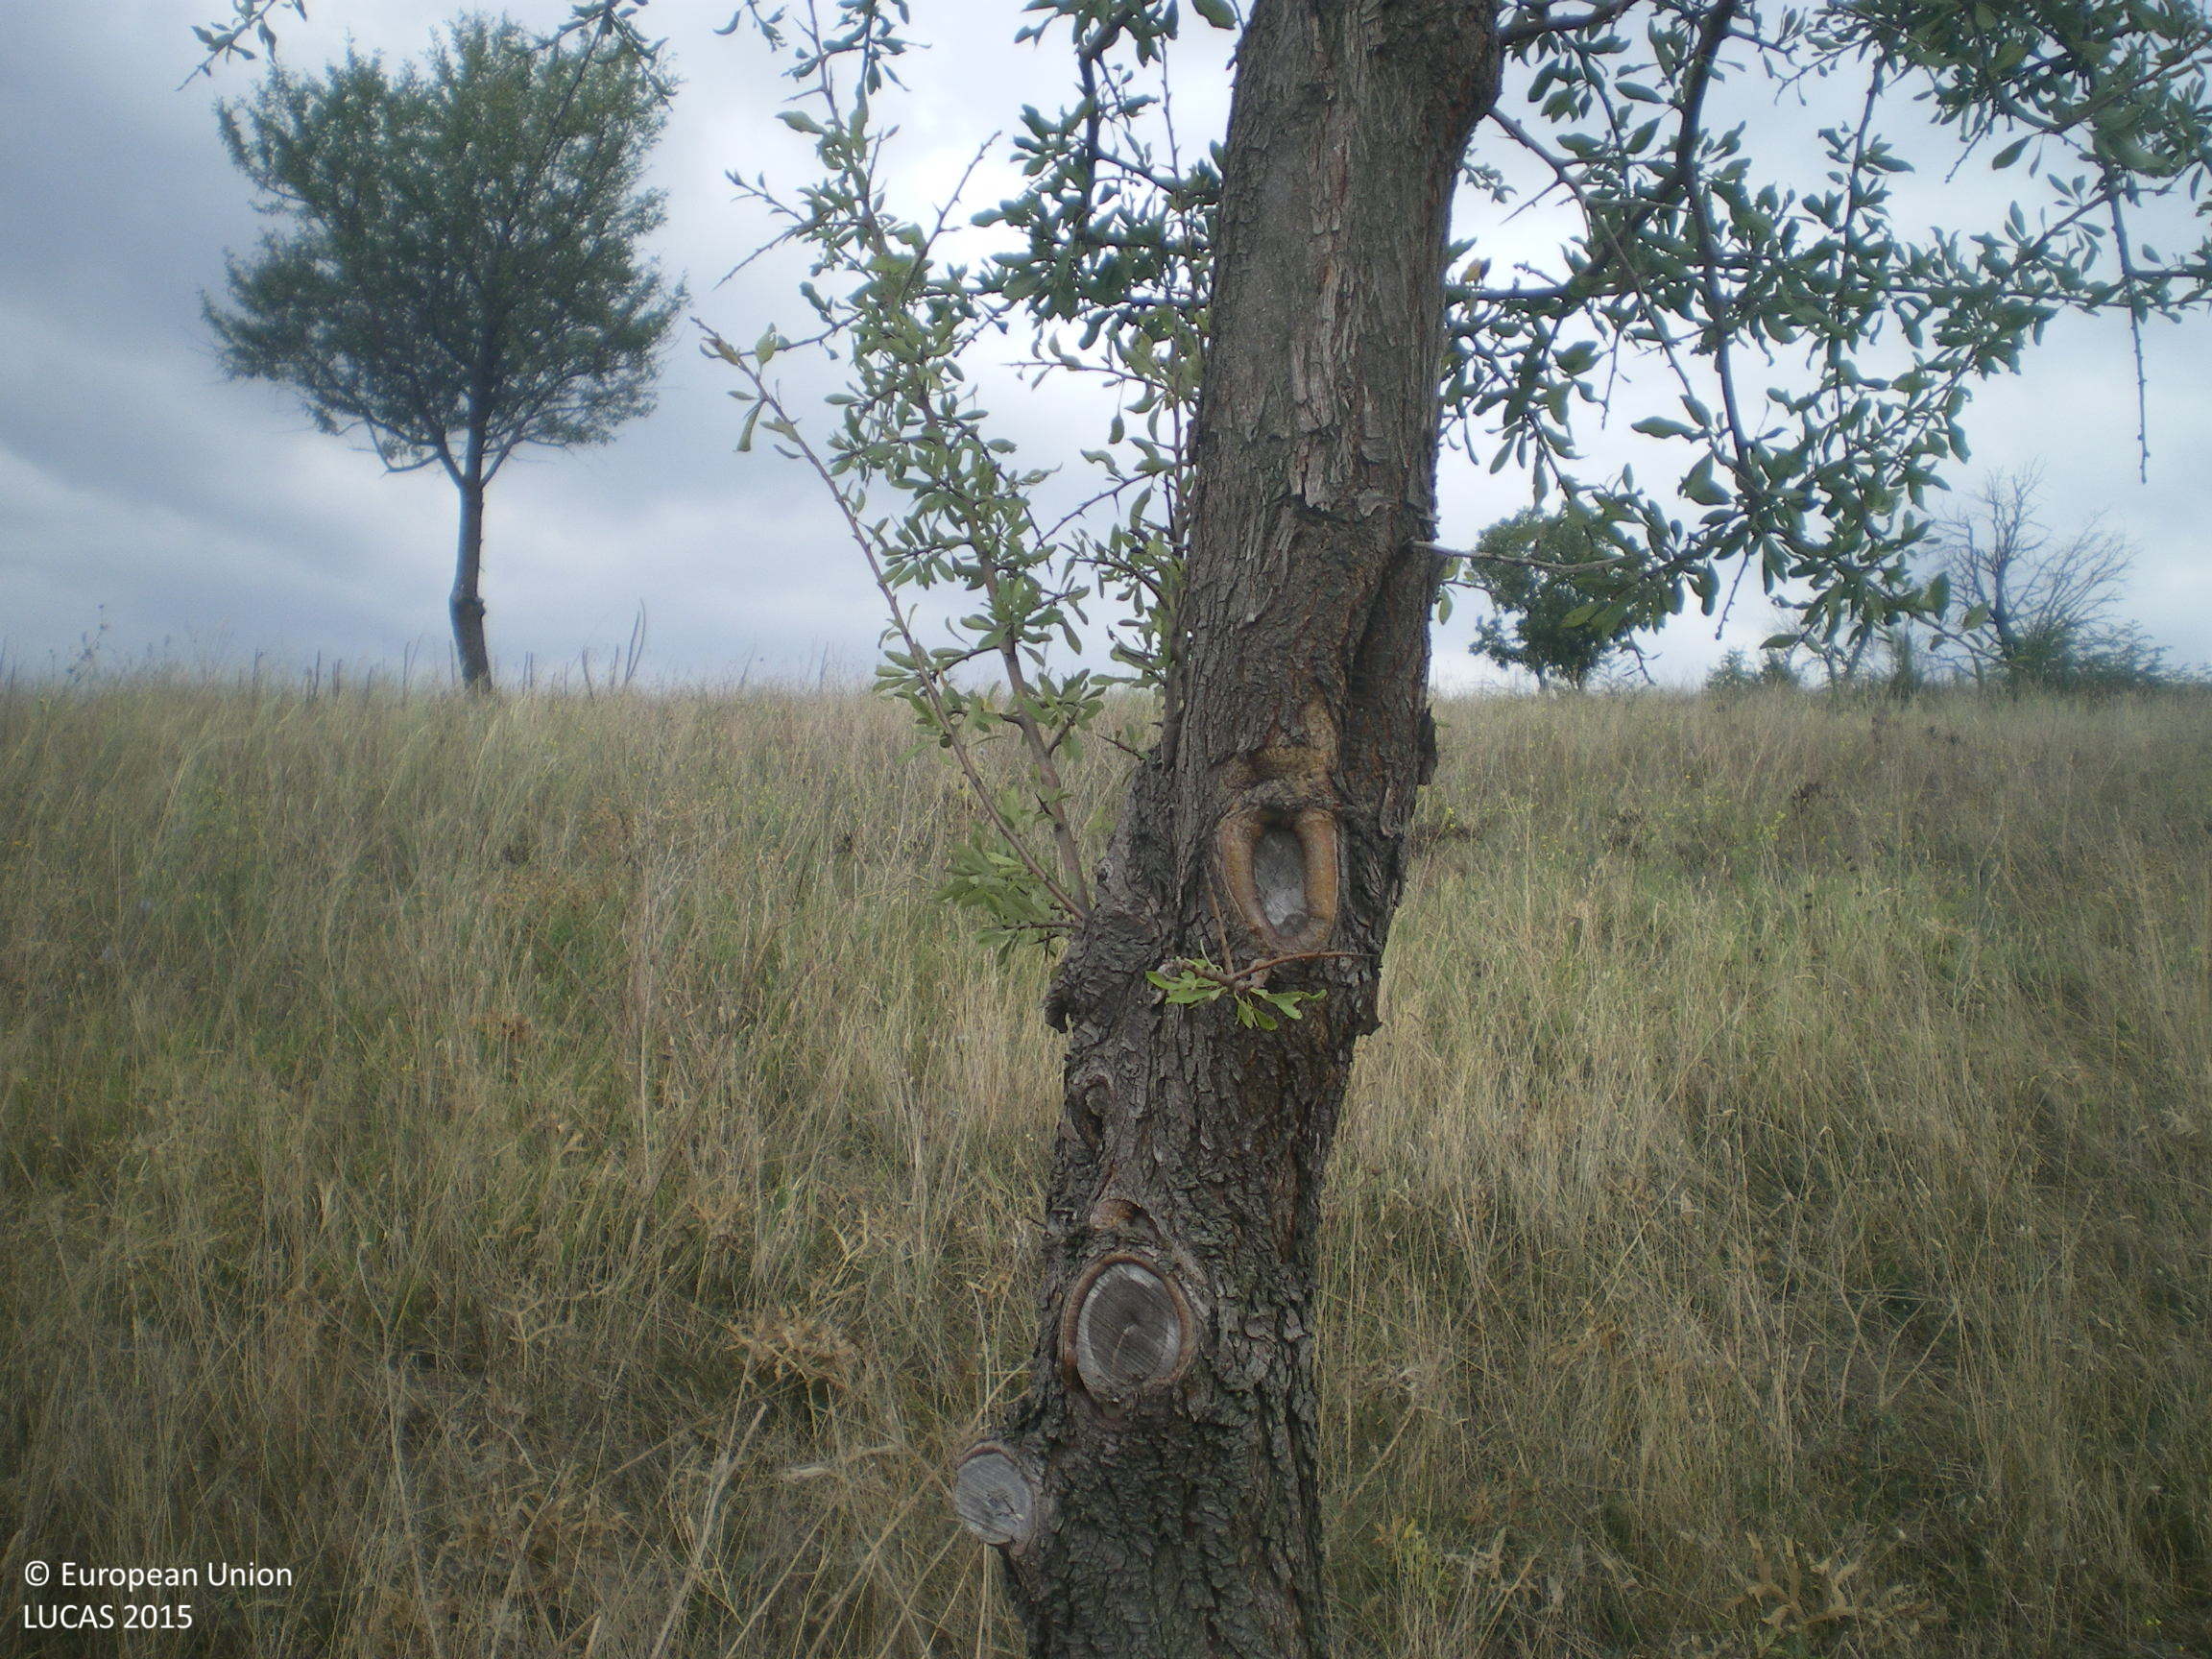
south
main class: Grassland
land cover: Grassland with sparse tree/shrub cover
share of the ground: > 75 %
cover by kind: herbaceous plants 90 %, broadleaved forest trees 5 %, shrubs 5 %
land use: Semi-natural and natural areas not in use
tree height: > 5 m
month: September
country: BG
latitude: 42.0190
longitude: 25.9788
